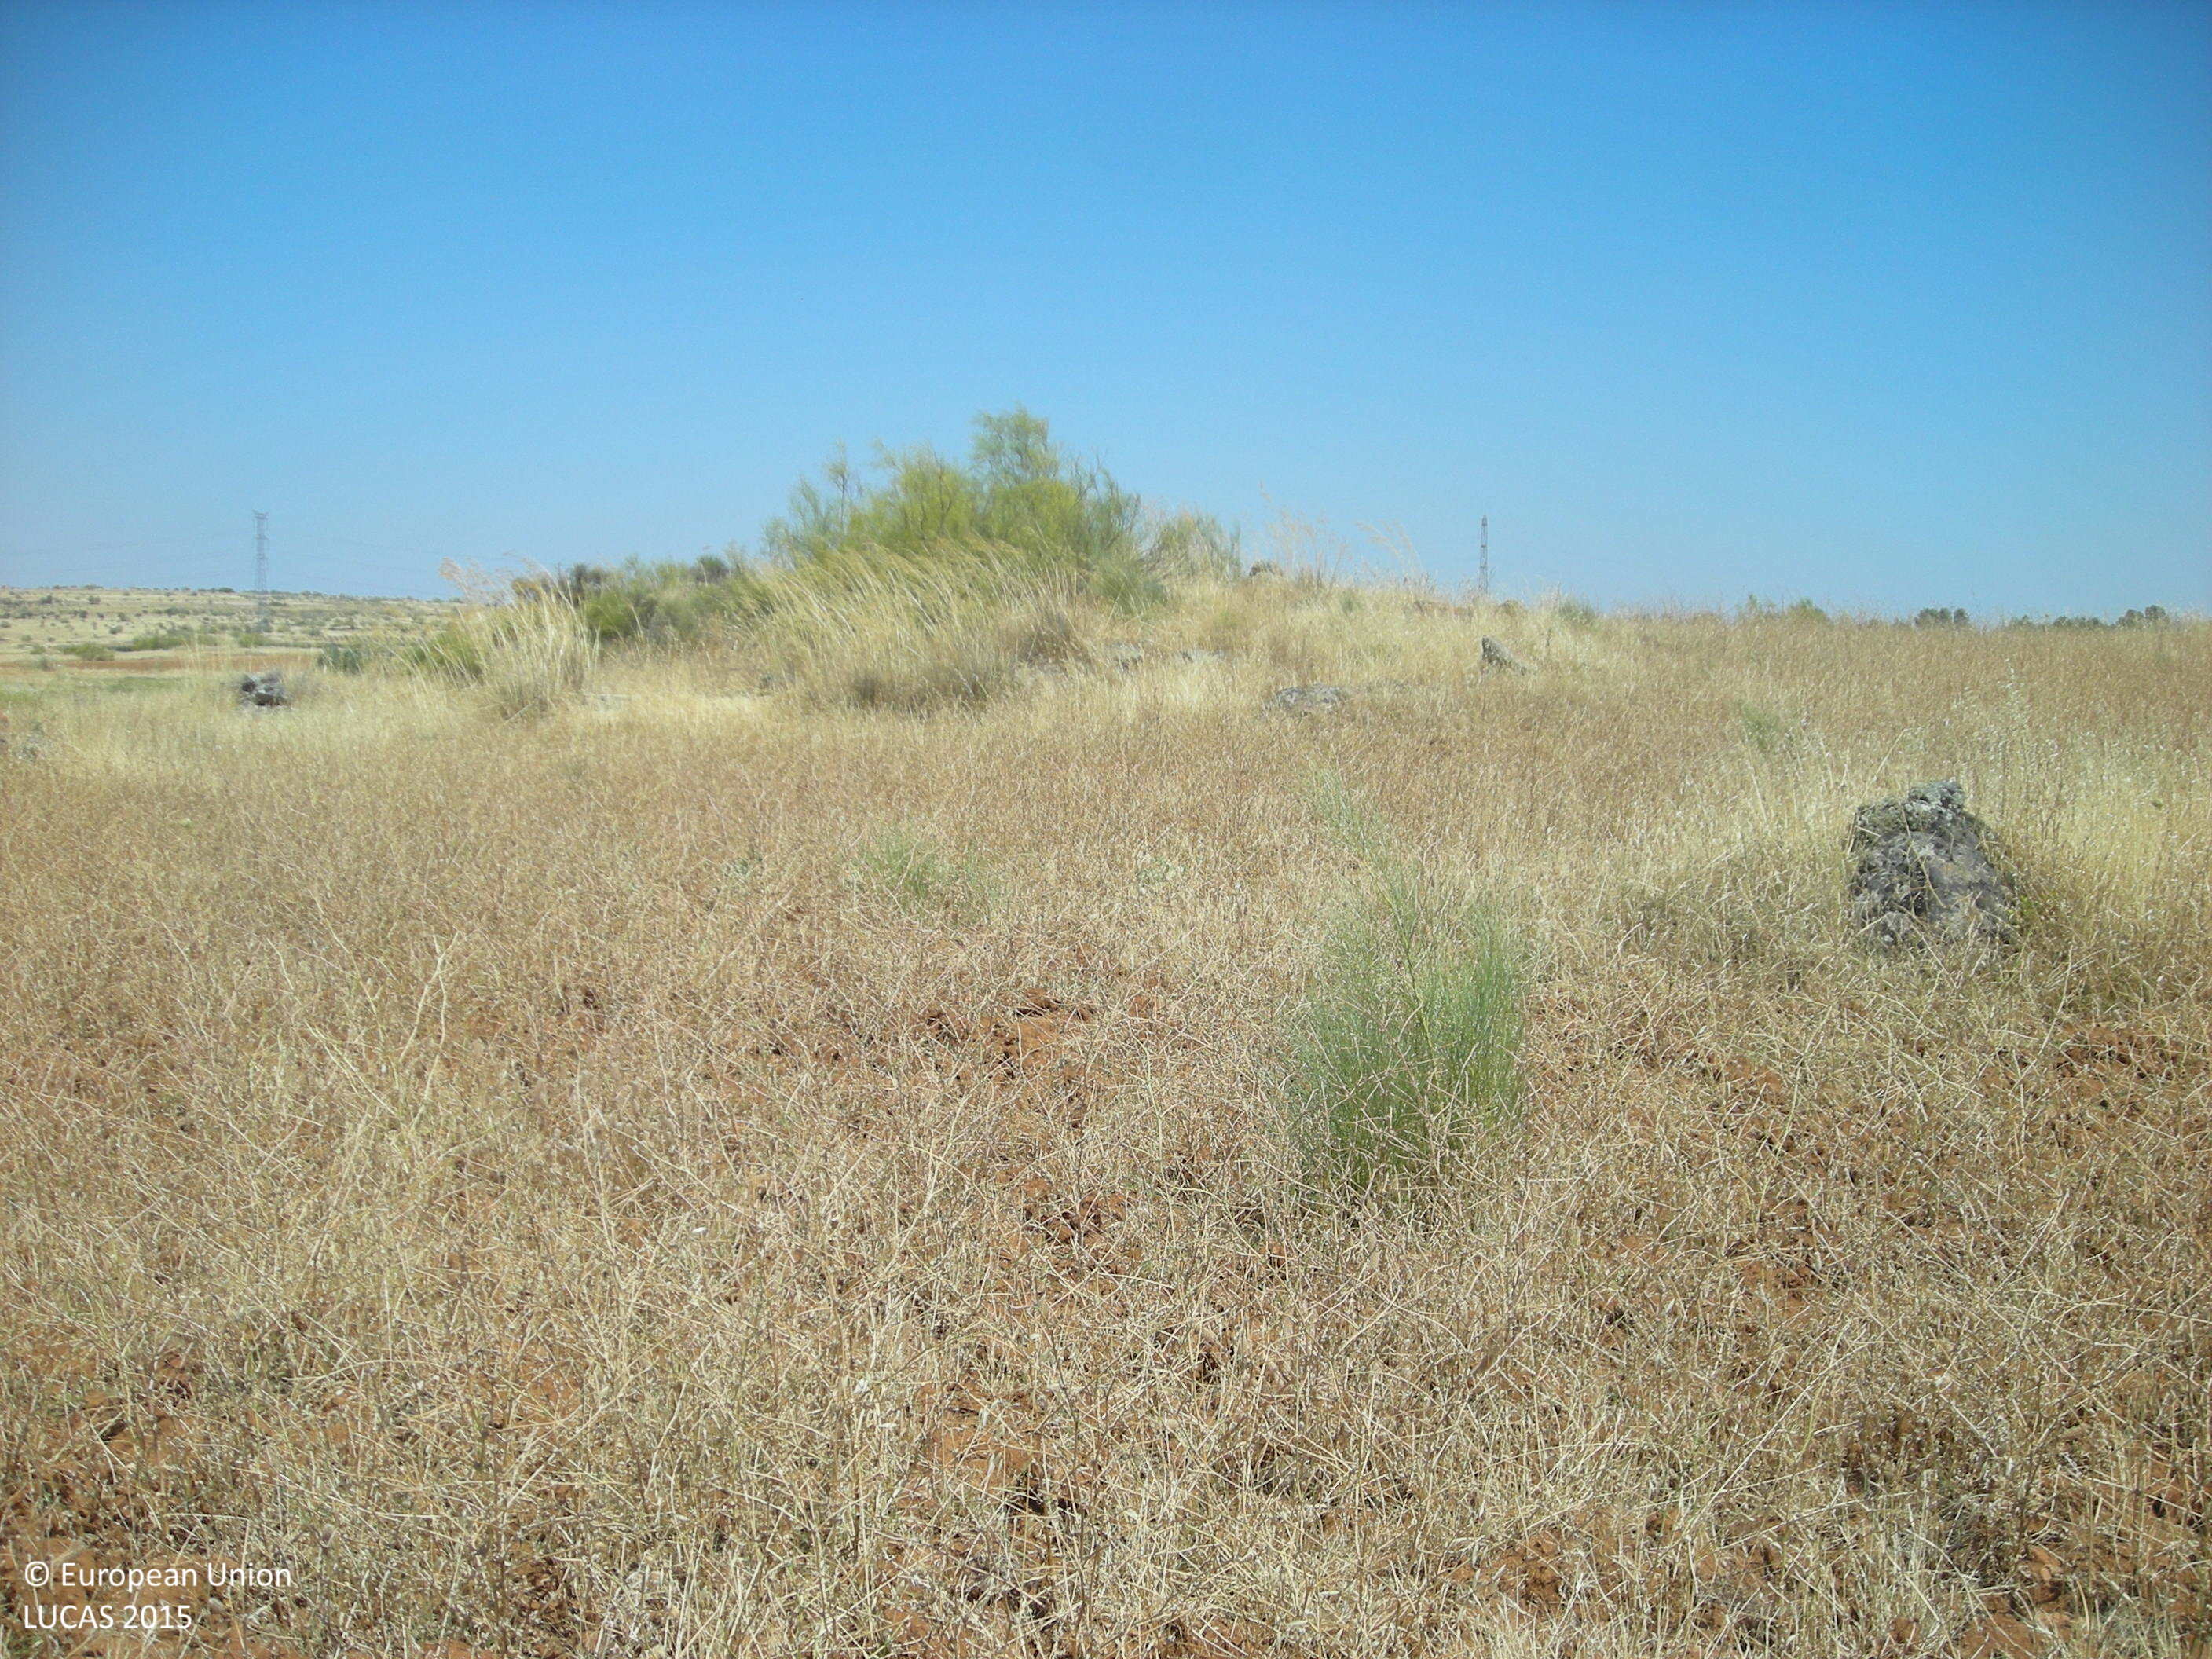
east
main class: Grassland
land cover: Grassland without tree/shrub cover
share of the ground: > 75 %
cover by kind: herbaceous plants 100 %
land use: Agriculture (excluding fallow land and kitchen gardens)
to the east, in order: Grassland without tree/shrub cover; Grassland with sparse tree/shrub cover; Olive groves; Grassland without tree/shrub cover
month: June
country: ES
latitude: 38.6512
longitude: -5.7730
